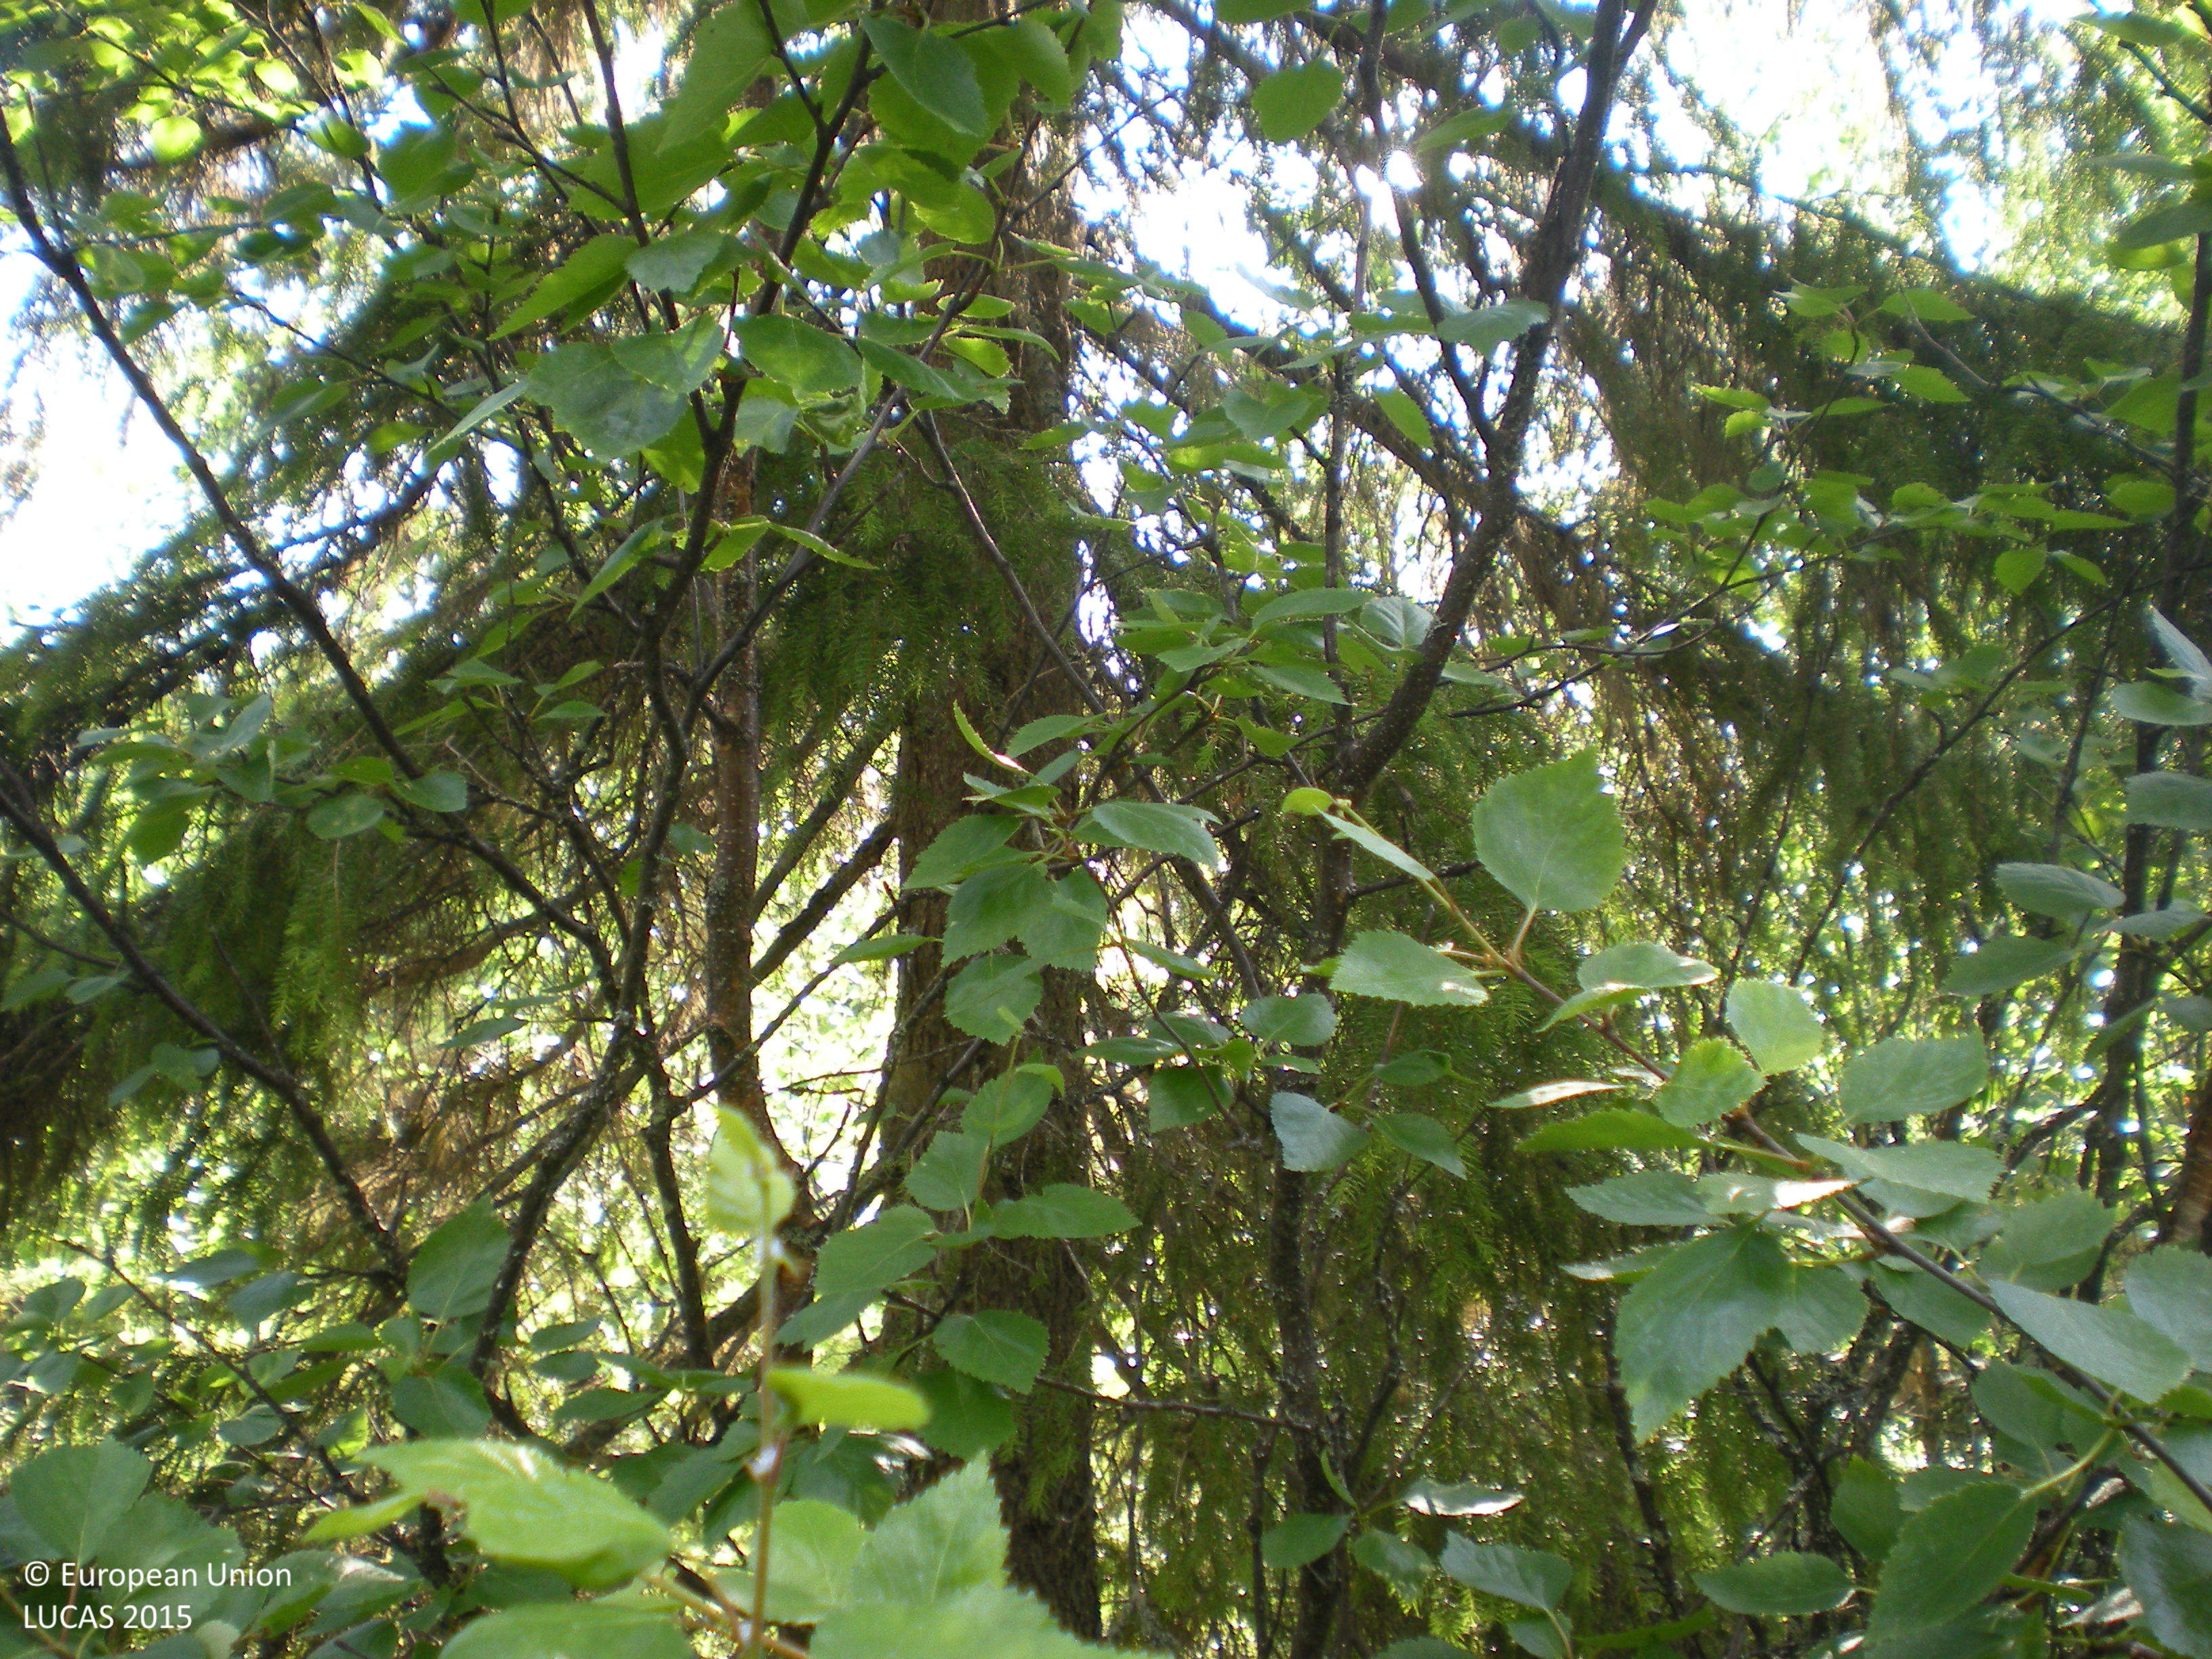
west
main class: Woodland
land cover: Spruce dominated mixed woodland
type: boreal forest
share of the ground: > 75 %
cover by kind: coniferous forest trees 60 %, broadleaved forest trees 20 %, shrubs 10 %, herbaceous plants 5 %, lichens and mosses 5 %
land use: Forestry
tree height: > 5 m
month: July
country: SE
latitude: 65.6025
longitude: 17.0543
